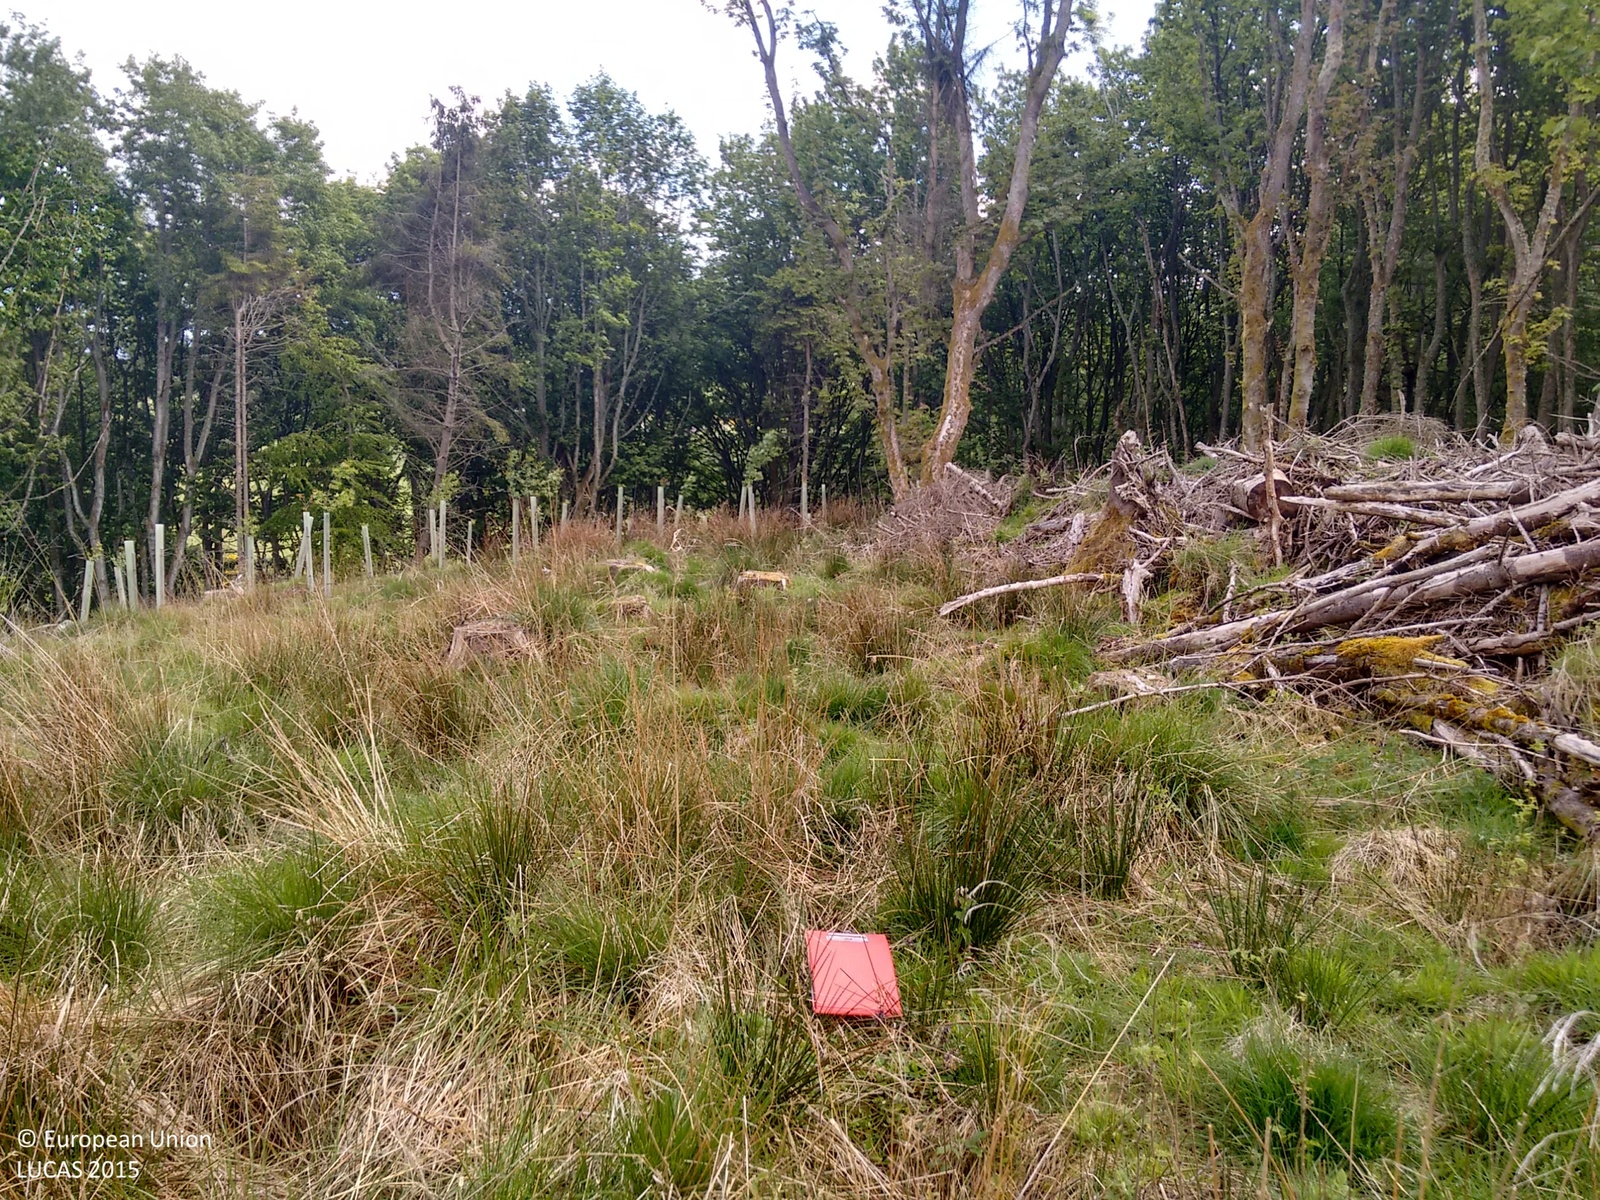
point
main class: Grassland
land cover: Grassland with sparse tree/shrub cover
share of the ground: > 75 %
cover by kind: herbaceous plants 85 %, broadleaved forest trees 5 %
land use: Forestry
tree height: > 5 m
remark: Clear cut
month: May
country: GB
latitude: 55.9380
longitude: -2.4985
